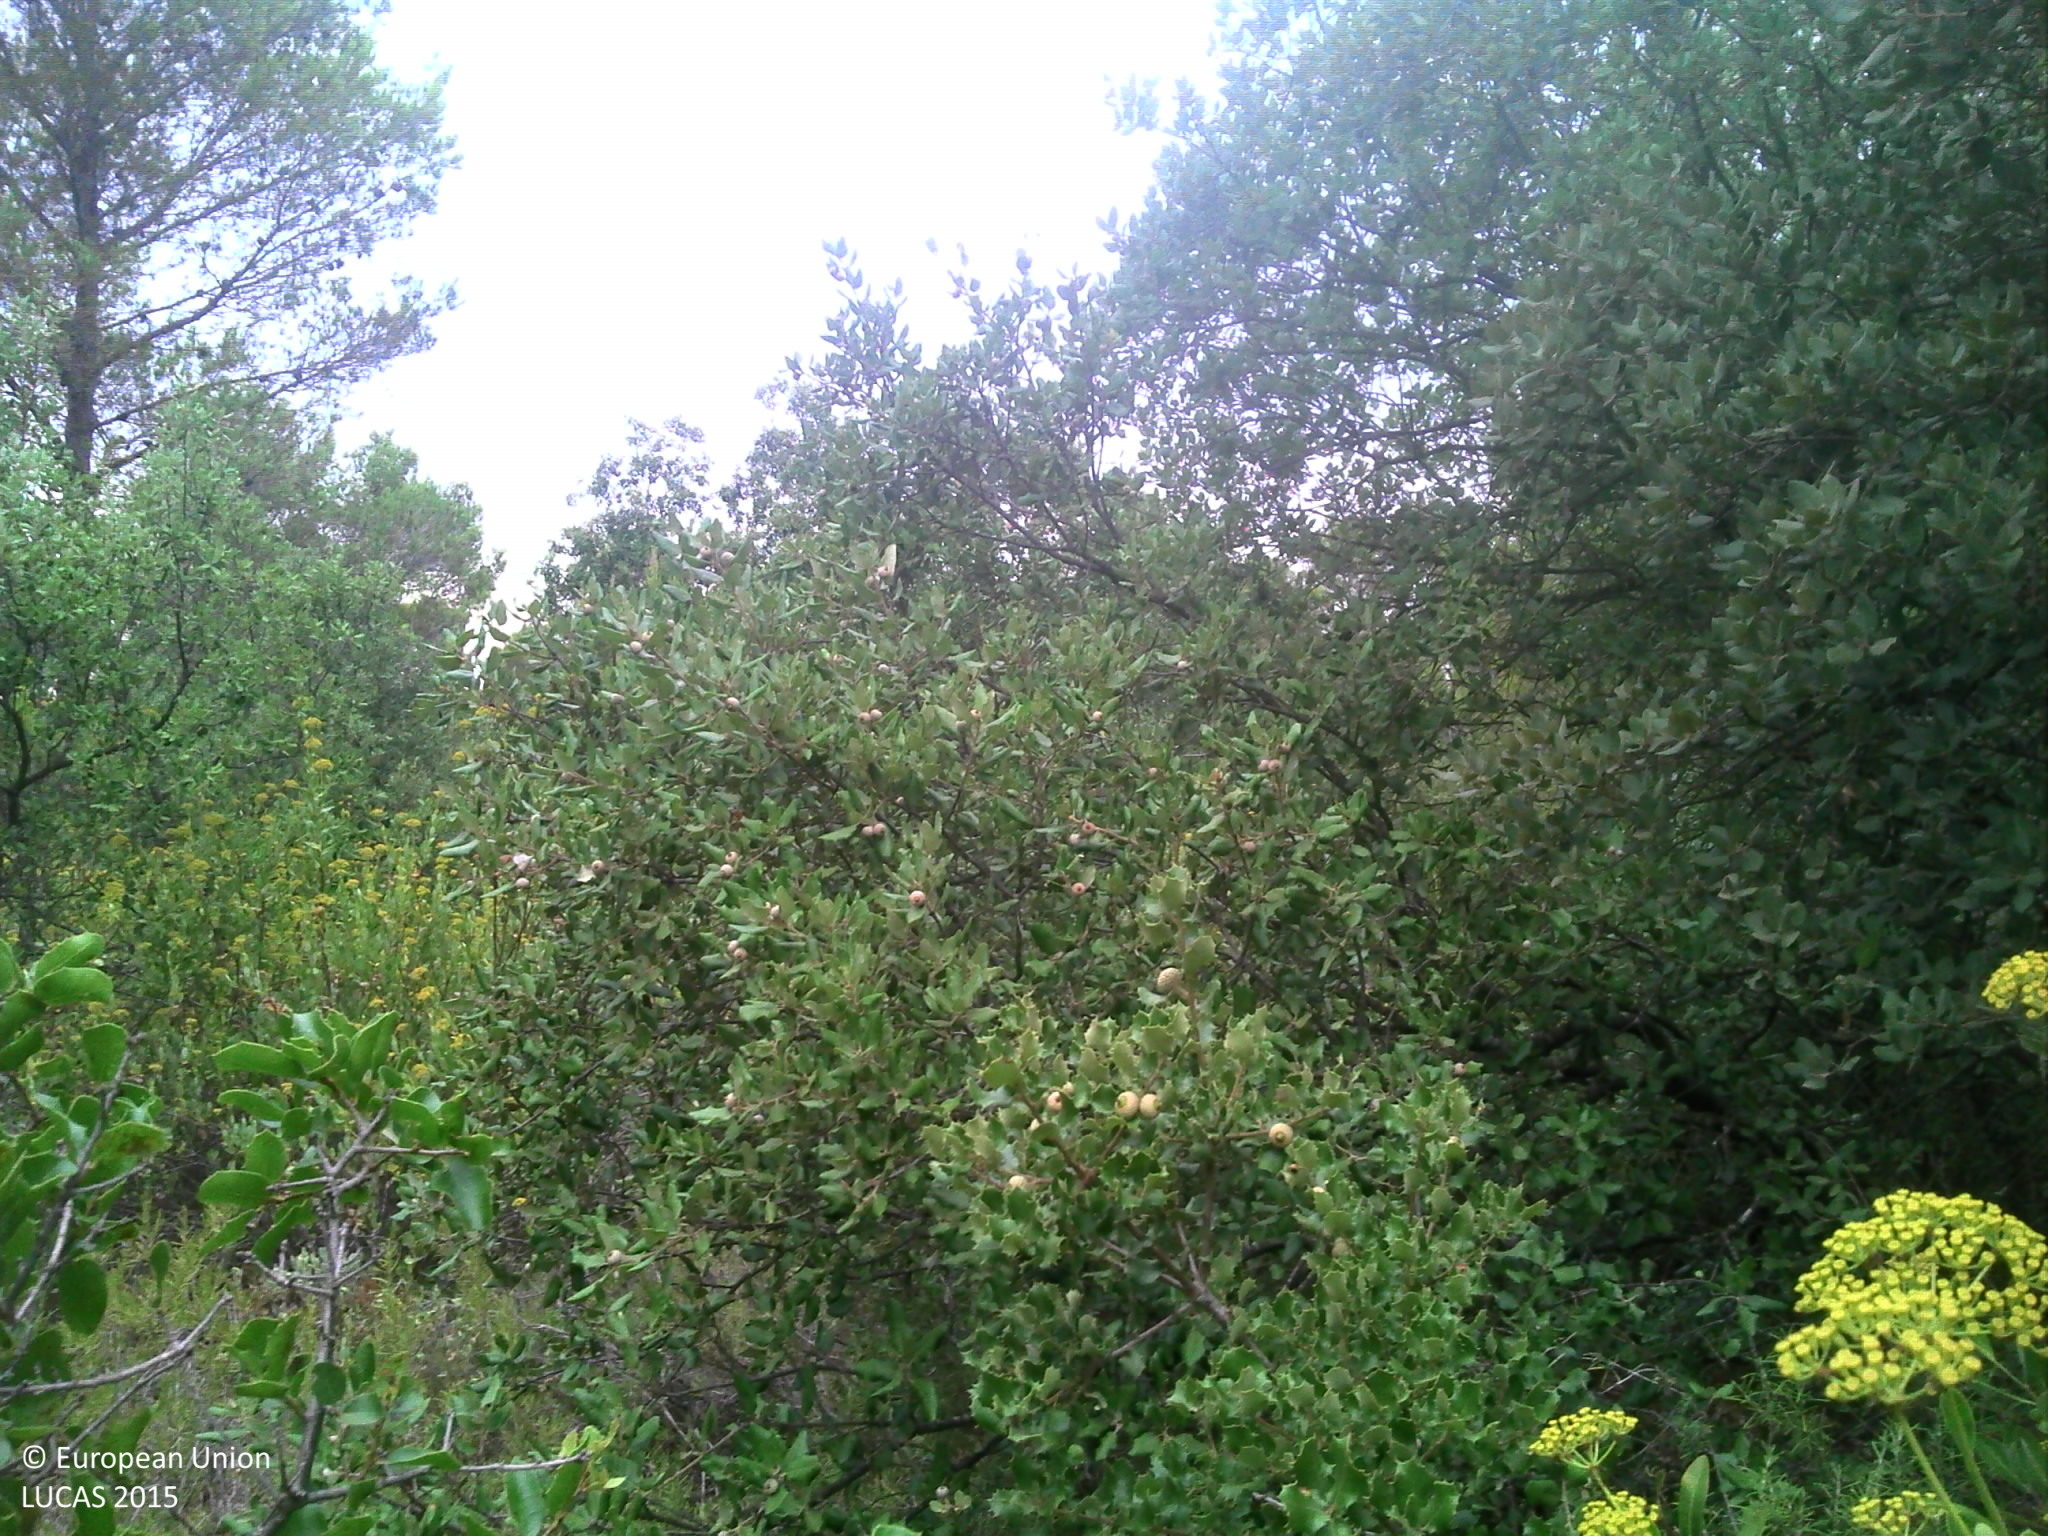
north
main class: Woodland
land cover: Broadleaved woodland
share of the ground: > 75 %
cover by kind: broadleaved forest trees 60 %, unconsolidated bare surface 20 %, shrubs 10 %, herbaceous plants 10 %
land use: Forestry
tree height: < 5 m
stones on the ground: 10 - 25 %
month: July
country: FR
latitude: 43.5816
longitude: 5.0436
